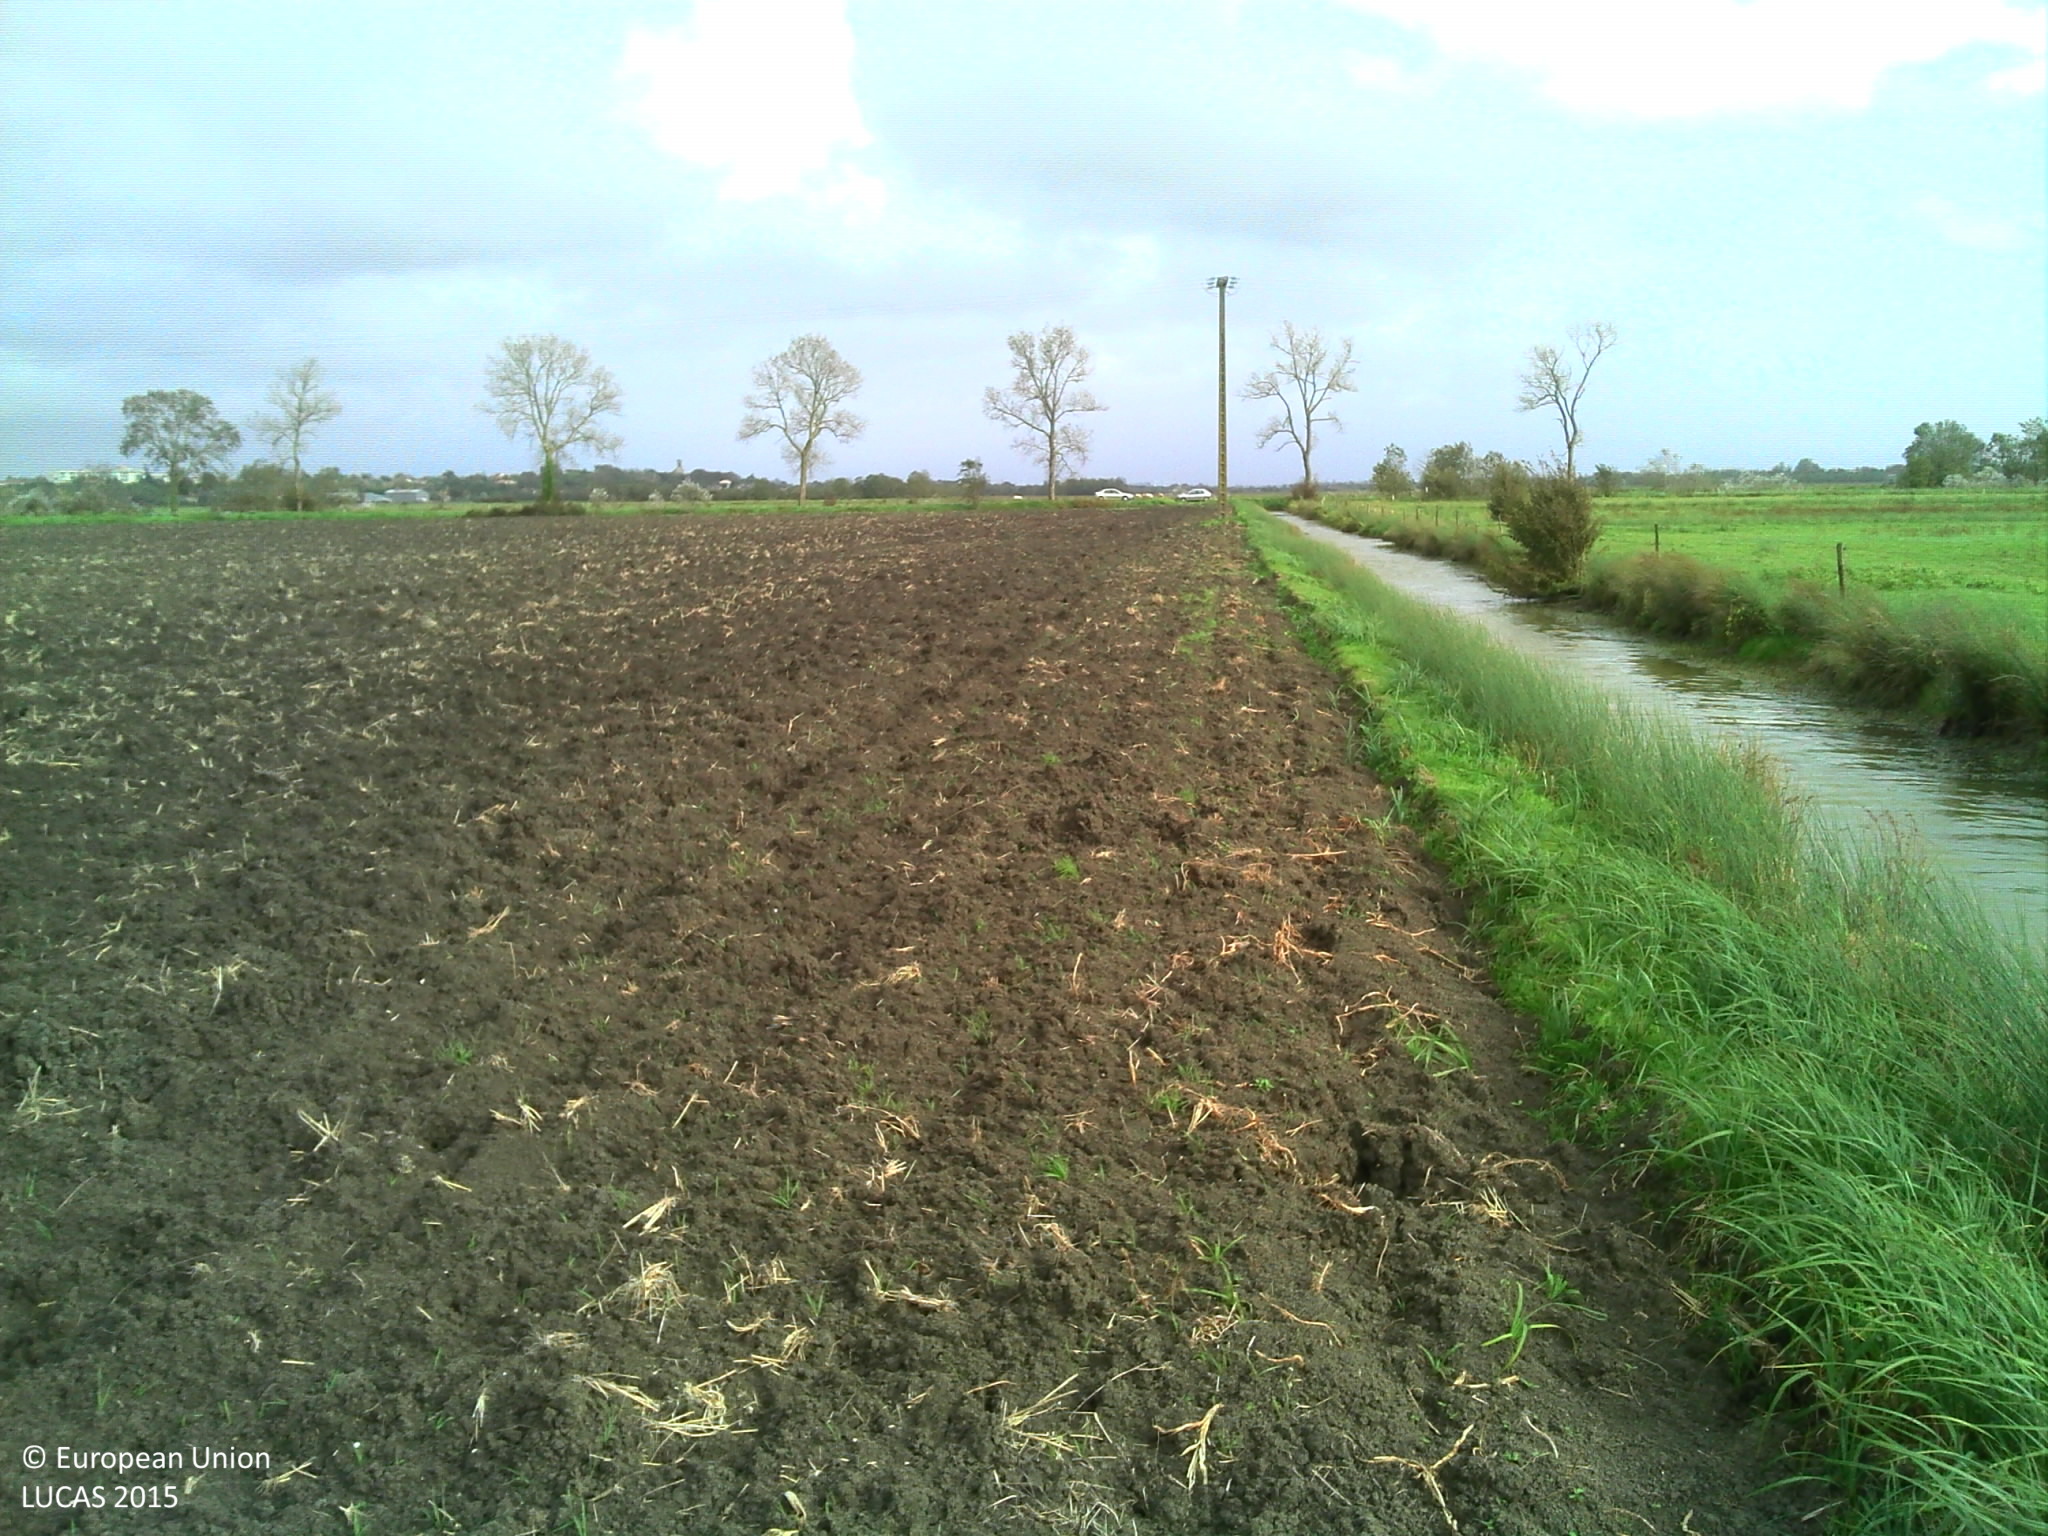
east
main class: Grassland
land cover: Grassland without tree/shrub cover
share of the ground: > 75 %
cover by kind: herbaceous plants 100 %
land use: Agriculture (excluding fallow land and kitchen gardens)
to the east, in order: Grassland without tree/shrub cover; Fences; Inland fresh running water; Grass margins; Other bare soil; Electric lines; Other bare soil; Ditches and canals; Managed hedges; Grass margins; Paved roads, cycling and walking lanes; Grass margins; Lines of trees; Inland fresh running water; Other bare soil; Grass margins
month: October
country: FR
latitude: 46.3949
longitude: -1.0473
